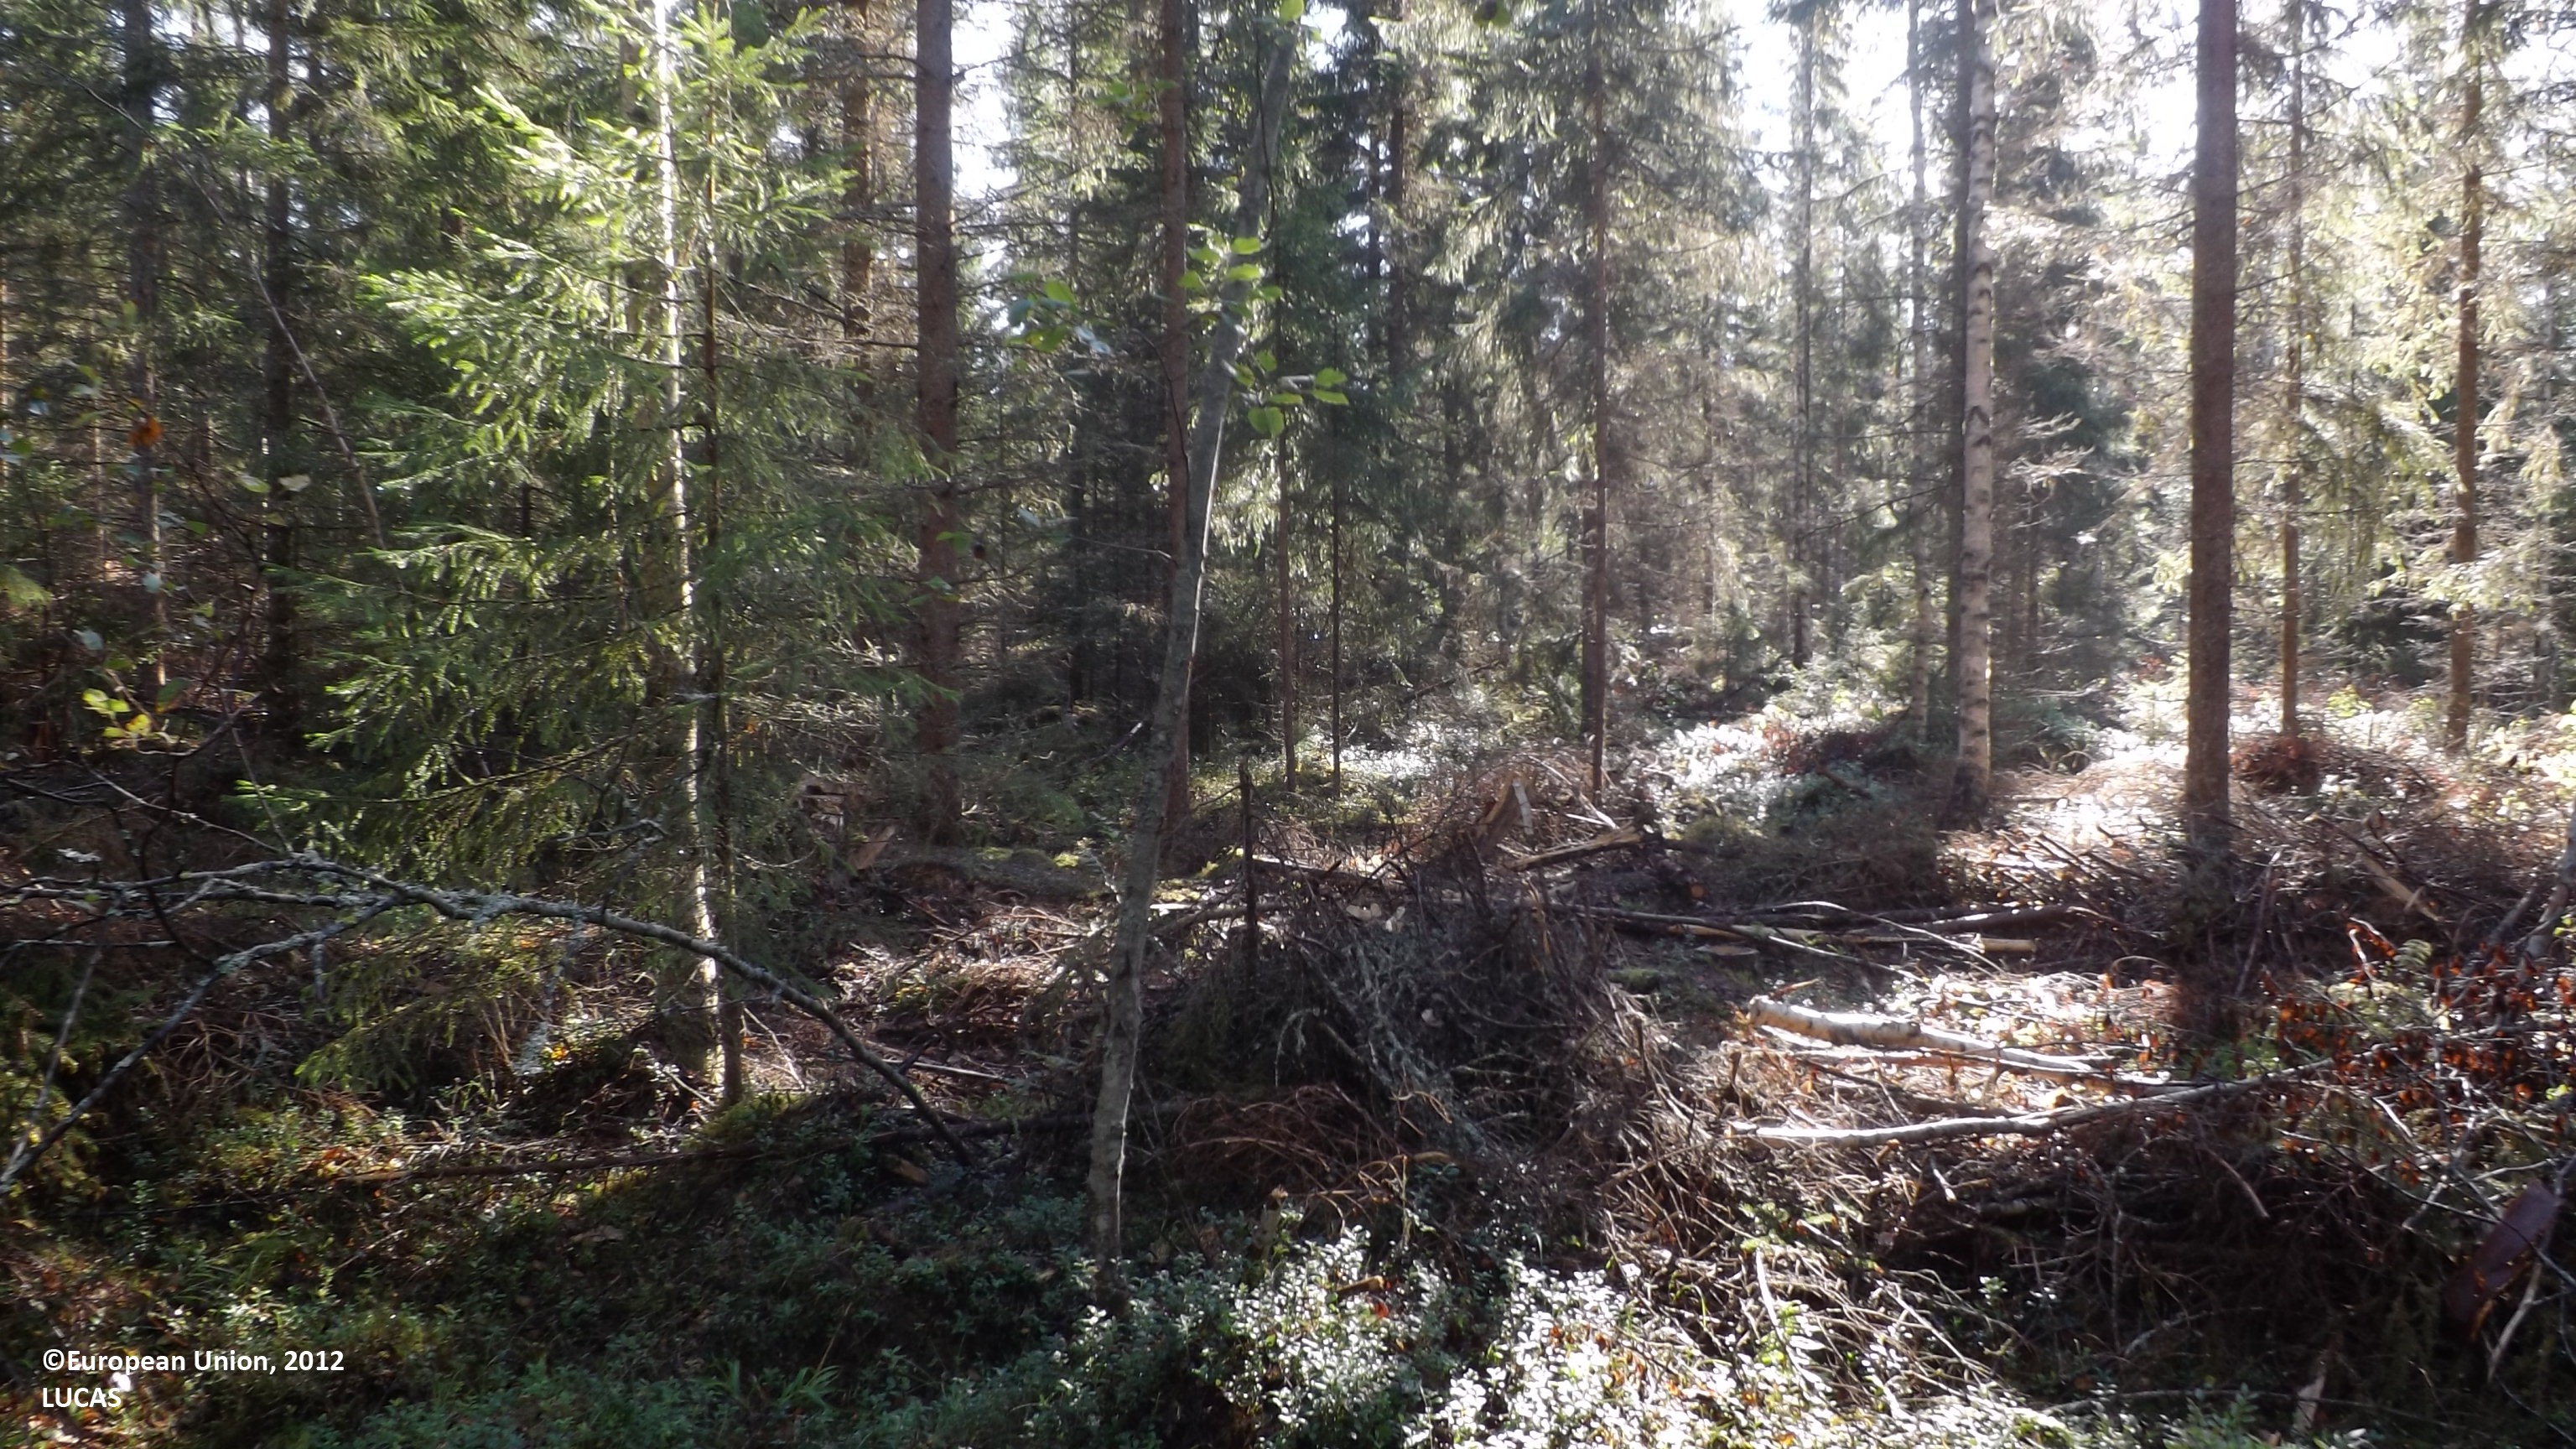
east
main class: Woodland
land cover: Spruce dominated mixed woodland
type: boreal forest
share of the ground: 50 - 75 %
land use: Forestry
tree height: > 5 m
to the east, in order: Spruce dominated mixed woodland; Tracks; Spruce dominated mixed woodland; Tracks; Spruce dominated mixed woodland; Tracks; Spruce dominated coniferous woodland; Tracks; Spruce dominated coniferous woodland; Tracks; Spruce dominated mixed woodland; Tracks; Spruce dominated mixed woodland; Tracks; Spruce dominated coniferous woodland; Tracks; Spruce dominated coniferous woodland; Tracks; Spruce dominated coniferous woodland; Tracks; Spruce dominated mixed woodland; Spruce dominated coniferous woodland
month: August
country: FI
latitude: 63.6467
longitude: 23.7751
